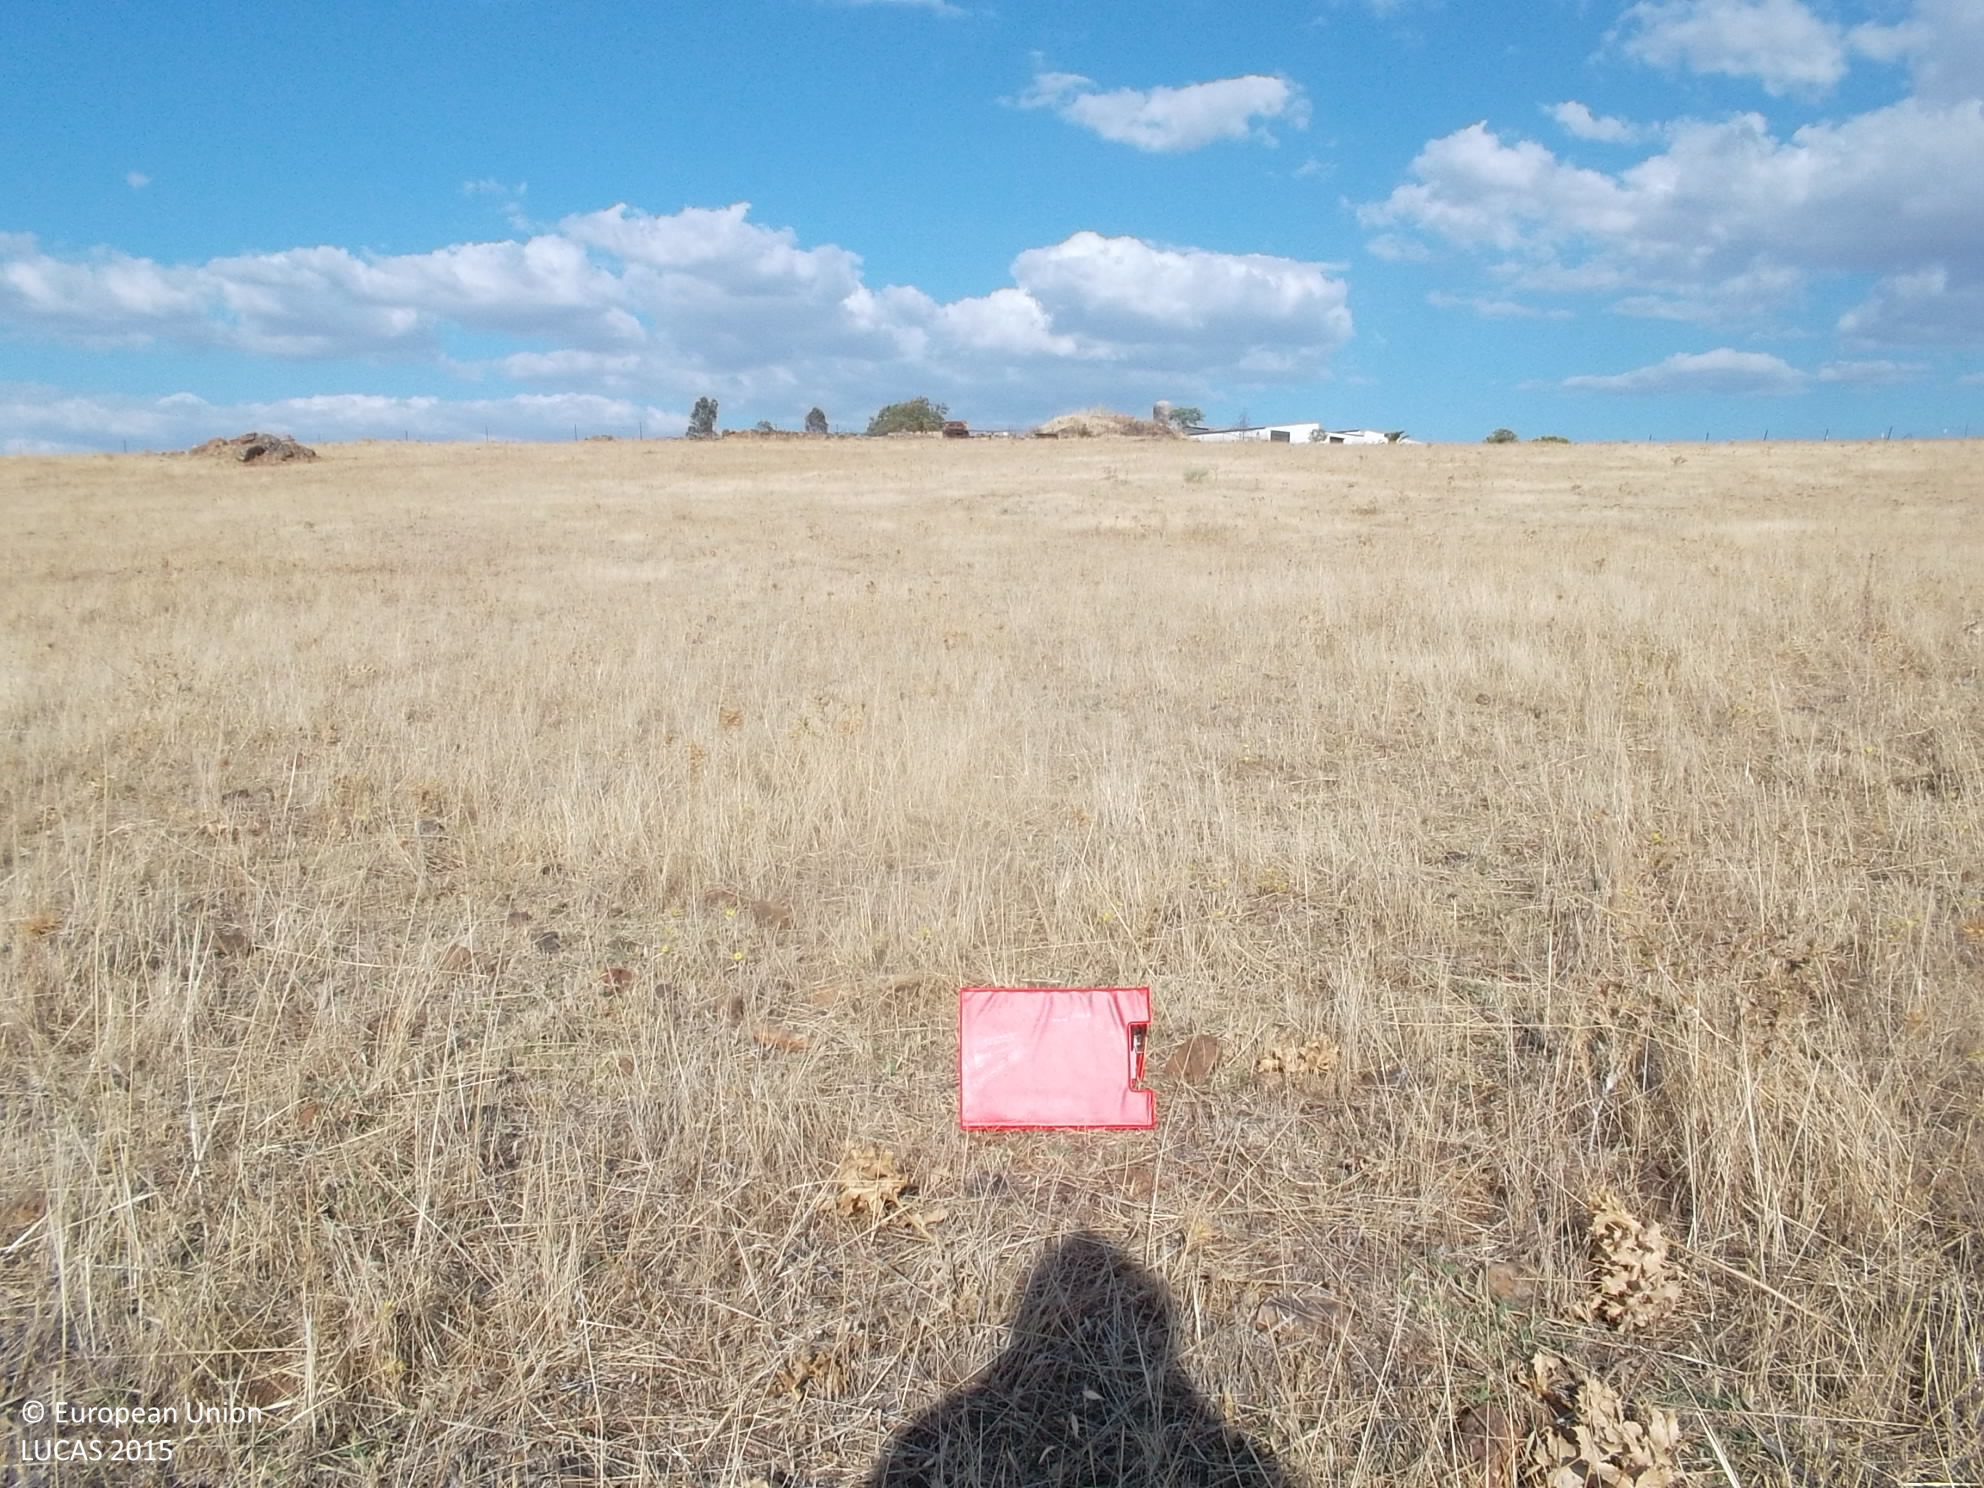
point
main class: Grassland
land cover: Spontaneously vegetated surfaces
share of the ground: > 75 %
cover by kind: herbaceous plants 100 %
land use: Fallow land
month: September
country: ES
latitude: 38.2365
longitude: -6.3722
